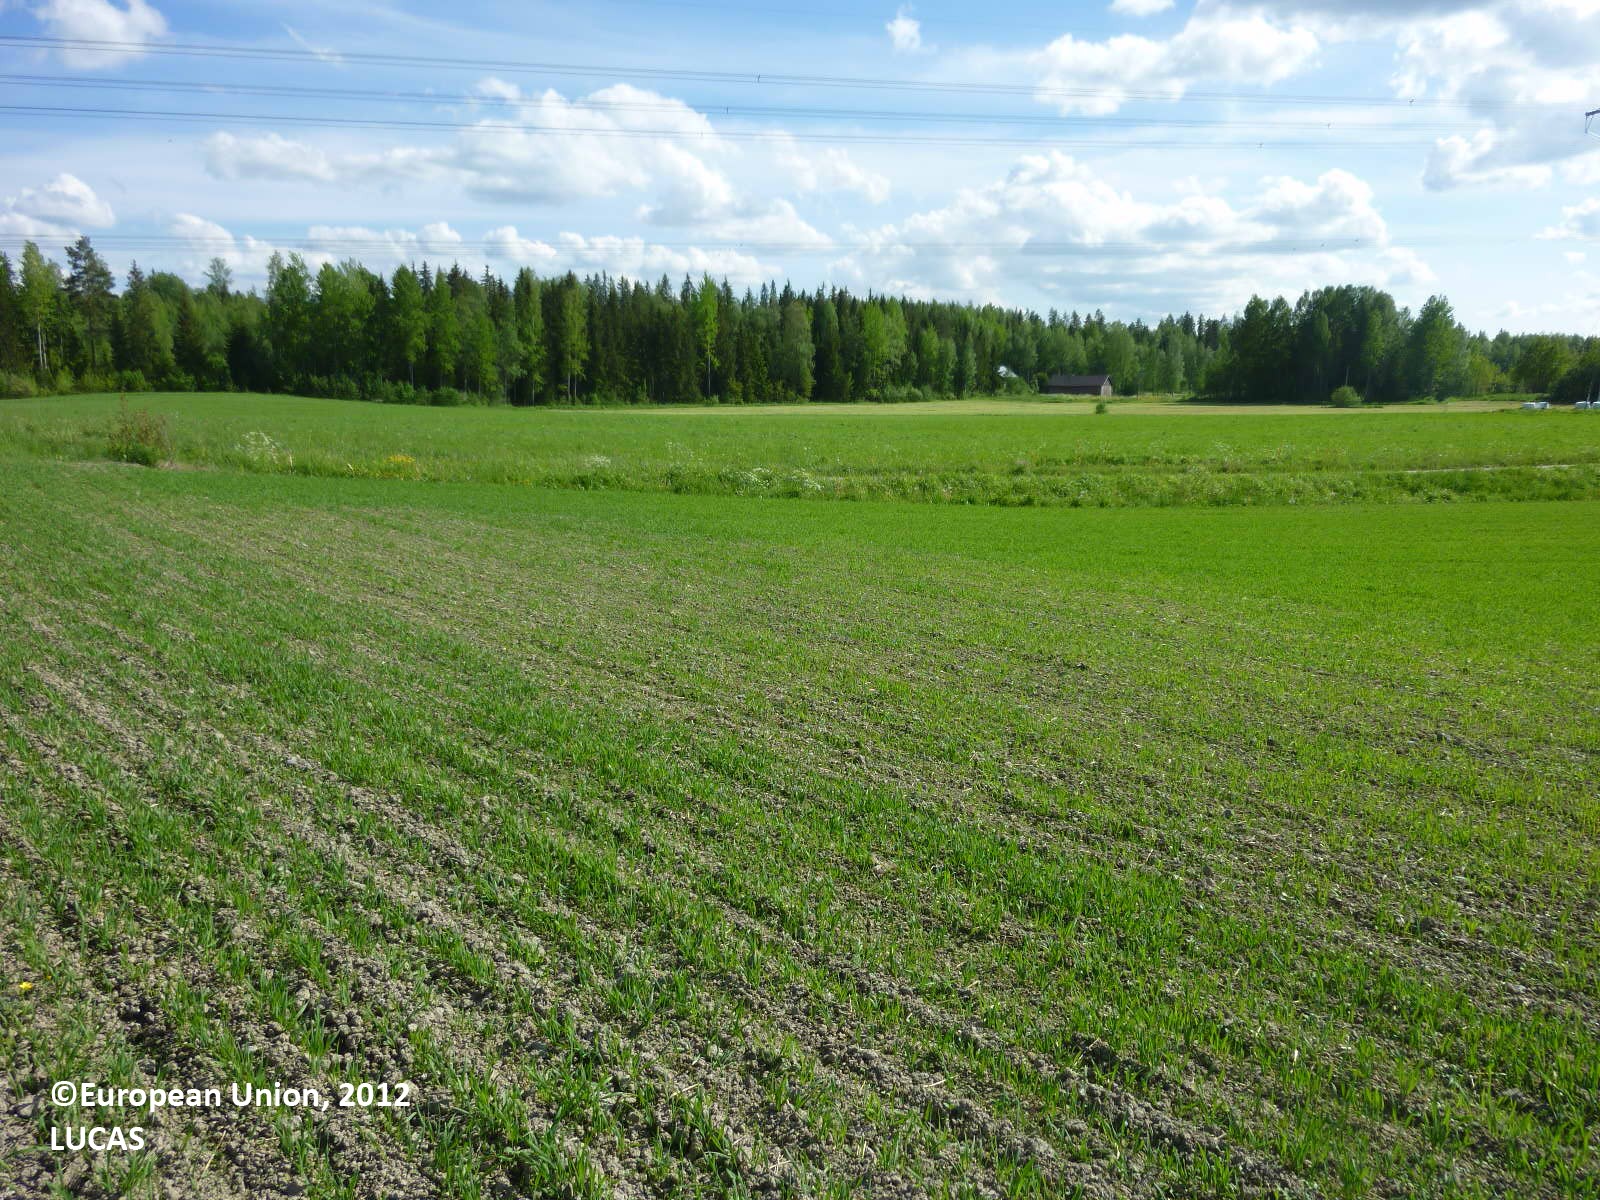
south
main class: Cropland
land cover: Oats
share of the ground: > 75 %
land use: Agriculture (excluding fallow land and kitchen gardens)
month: June
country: FI
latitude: 61.4233
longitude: 22.7933
